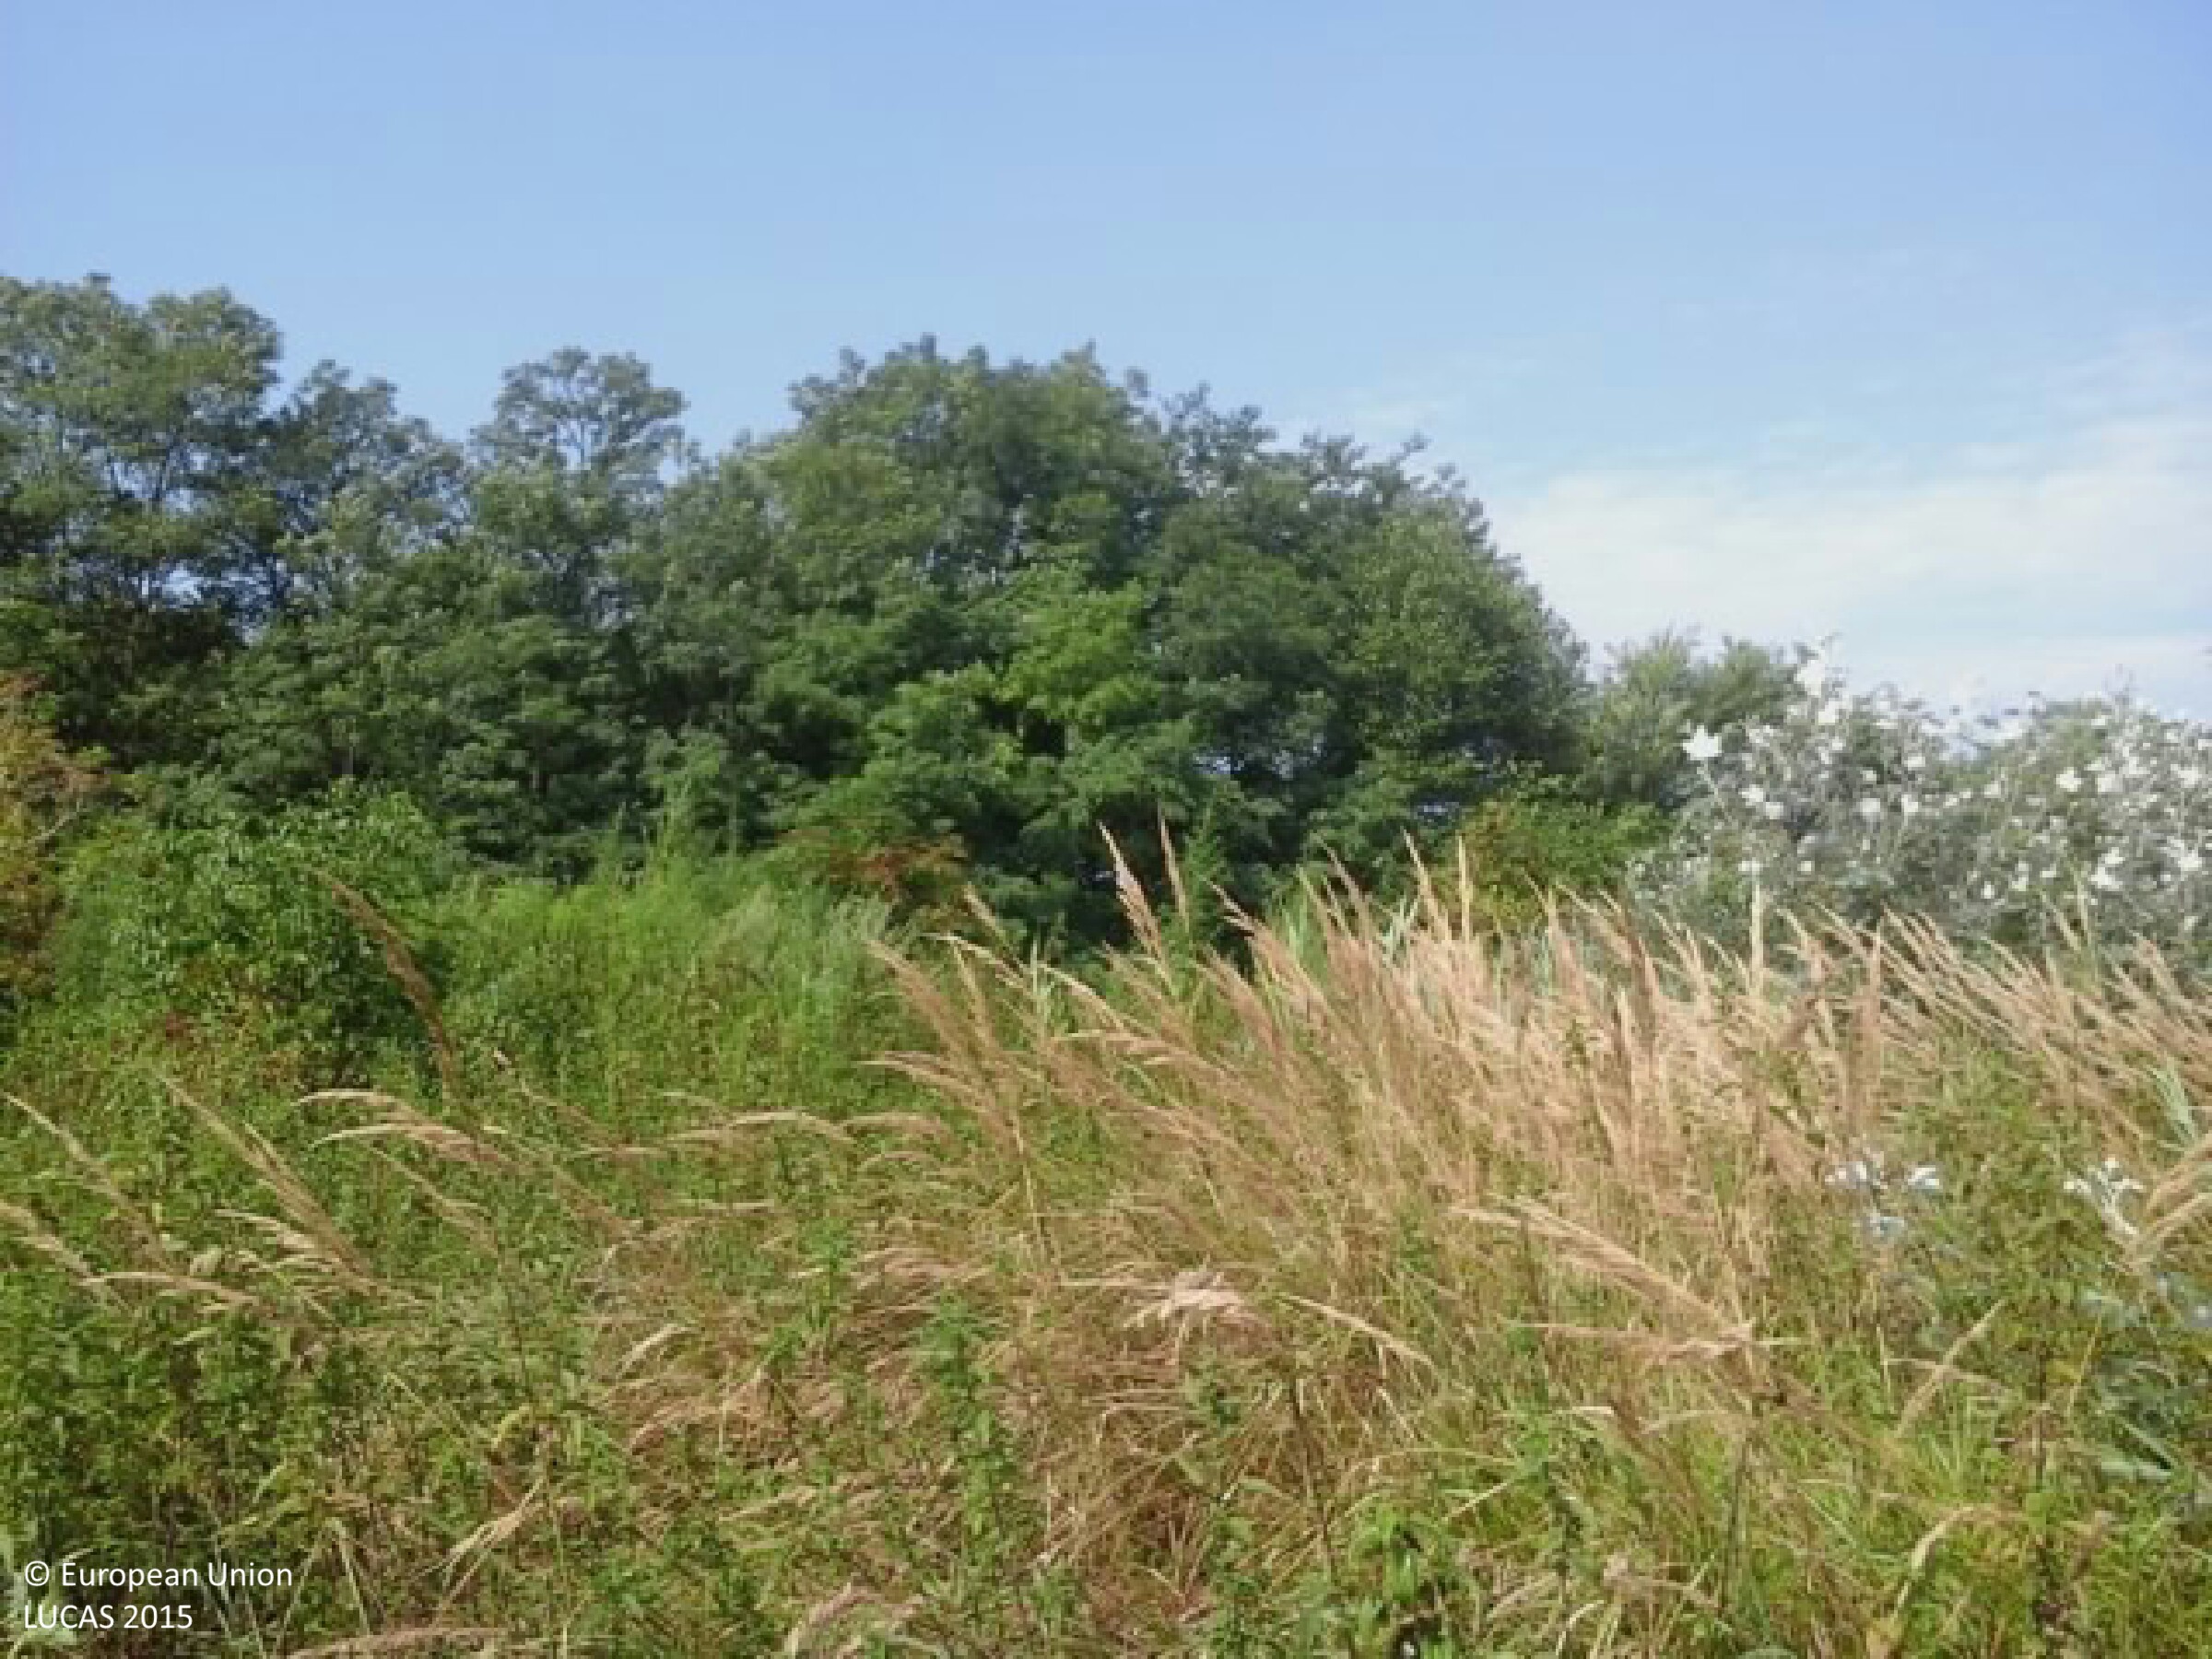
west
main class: Grassland
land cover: Spontaneously vegetated surfaces
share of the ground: > 75 %
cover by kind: herbaceous plants 100 %
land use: Fallow land
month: August
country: HU
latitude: 47.1744
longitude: 19.7463
